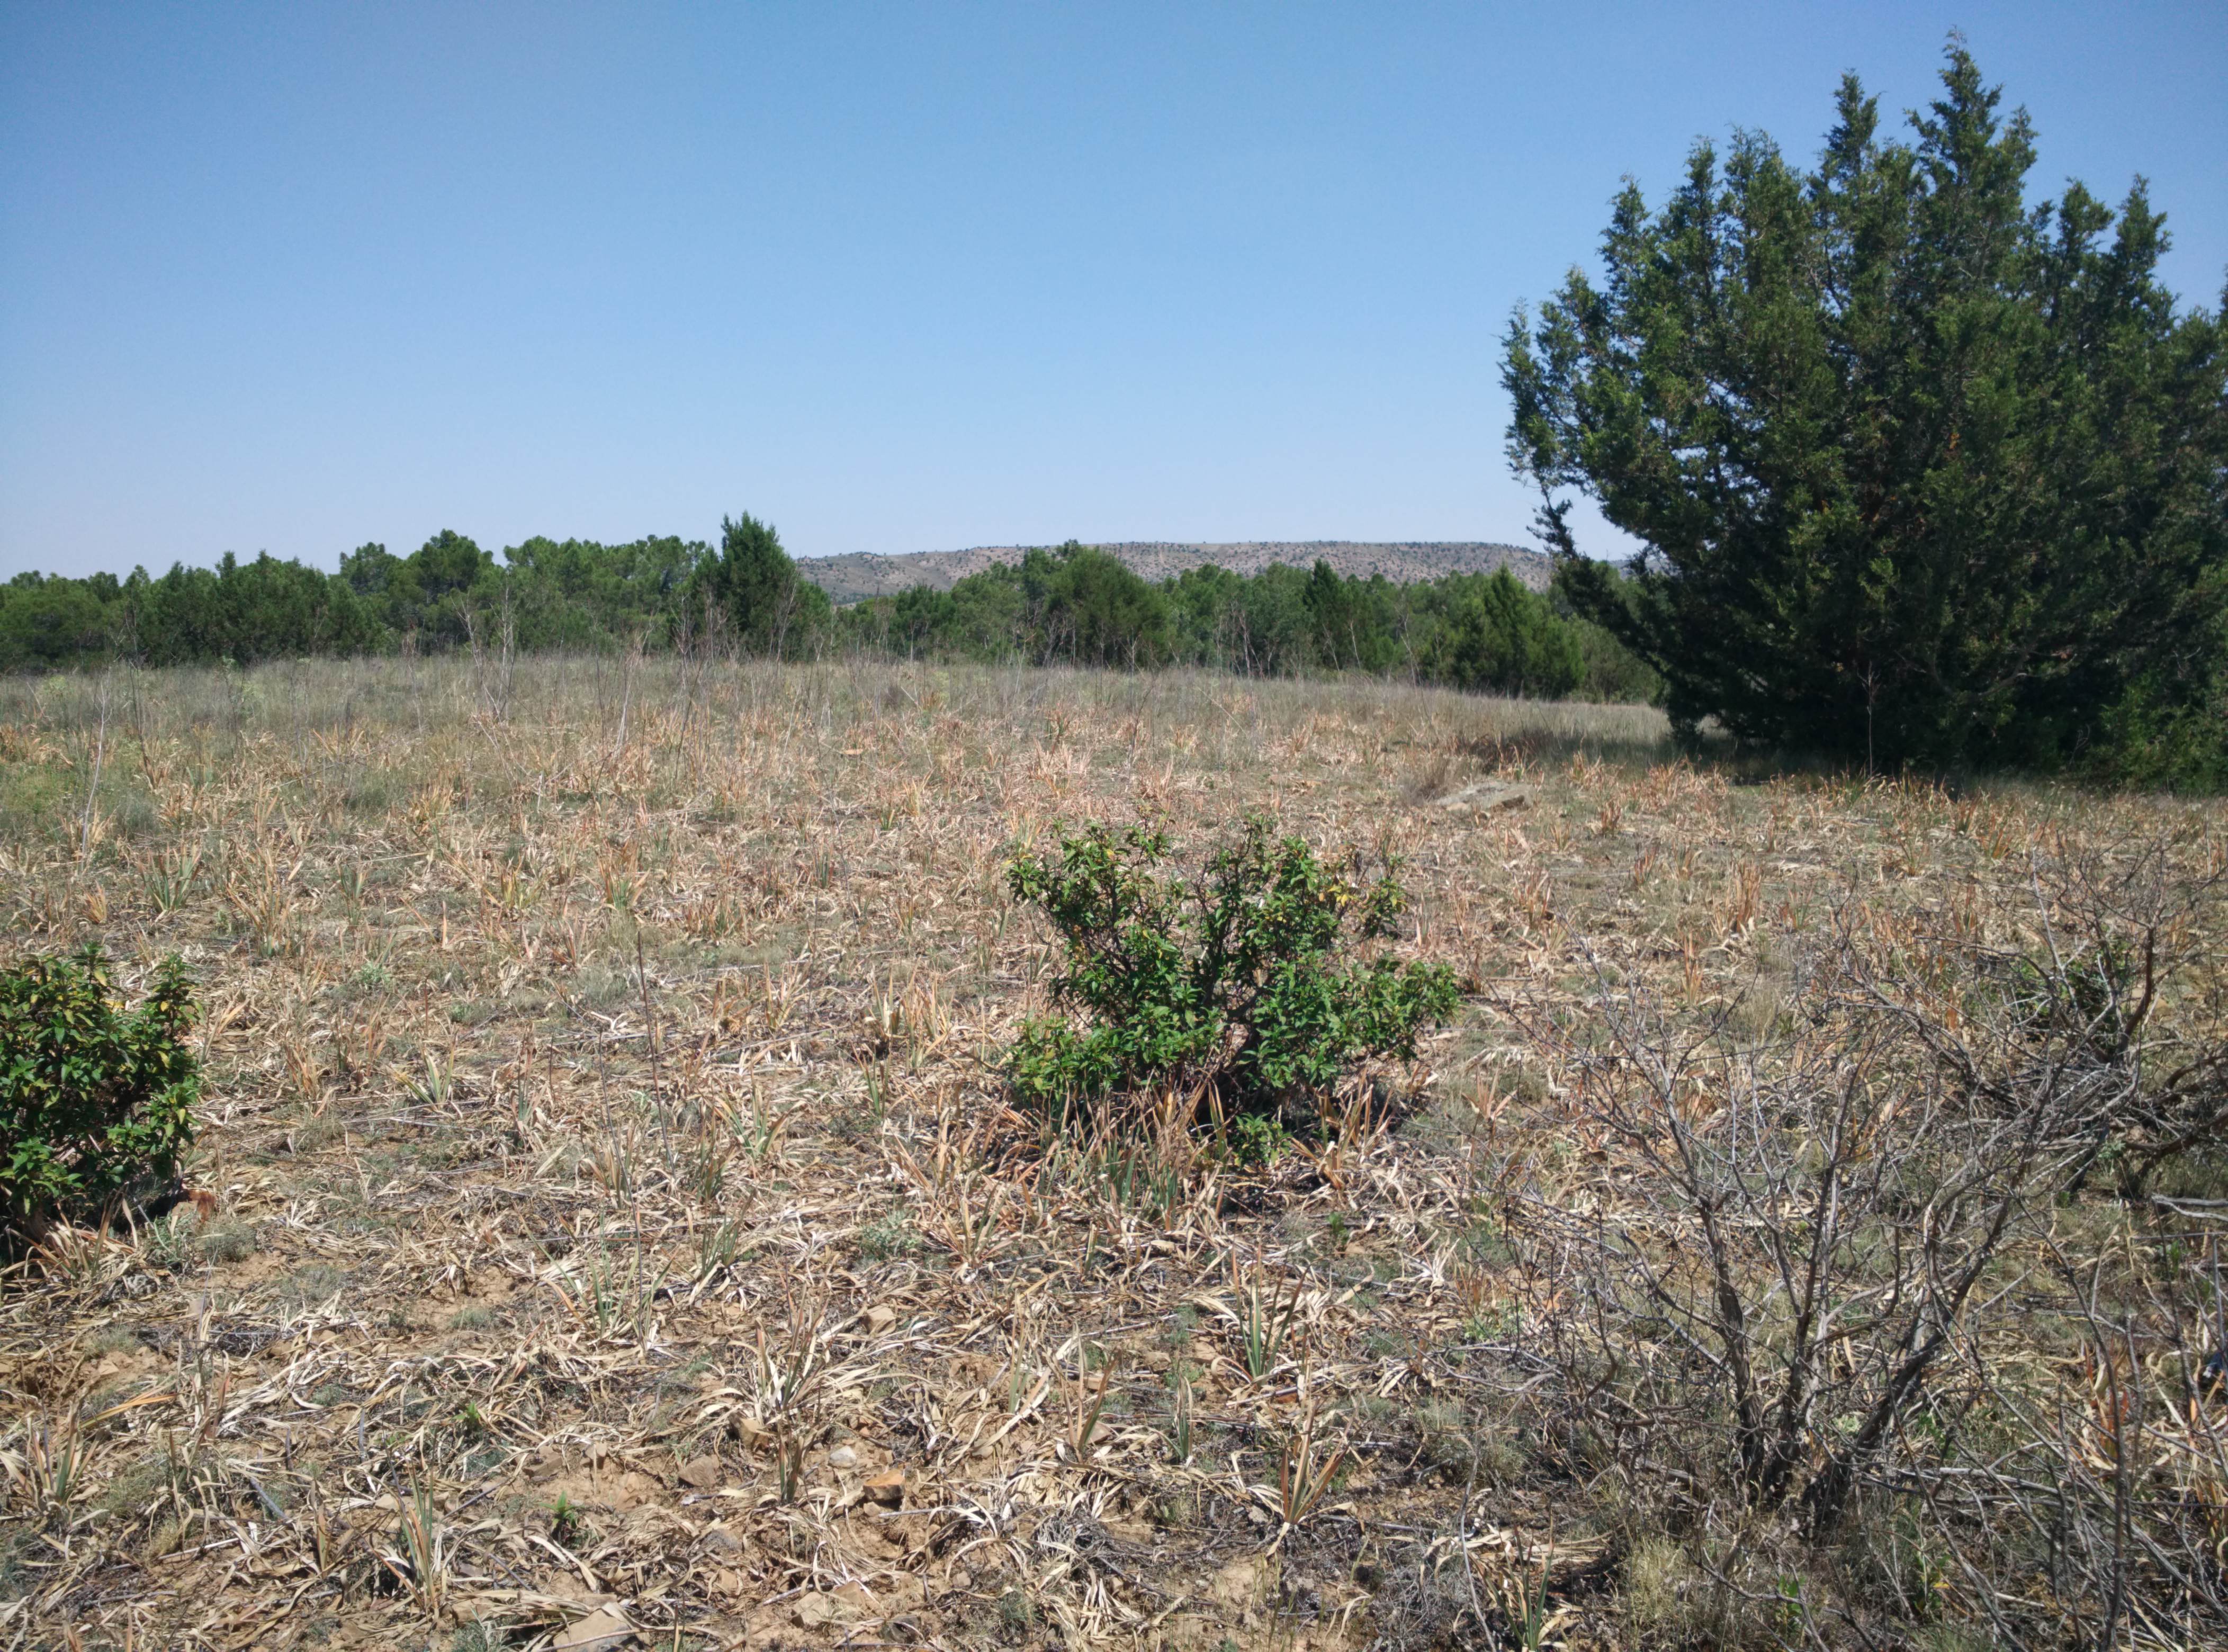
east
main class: Woodland
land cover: Pine dominated coniferous woodland
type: coniferous forest of the mediterranean region
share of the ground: 25 - 50 %
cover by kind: shrubs 60 %, coniferous forest trees 35 %, unconsolidated bare surface 5 %
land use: Semi-natural and natural areas not in use
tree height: > 5 m
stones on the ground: < 10 %
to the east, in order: Pine dominated coniferous woodland; Grassland without tree/shrub cover; Shrubland without tree cover; Pine dominated coniferous woodland; Shrubland without tree cover
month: June
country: ES
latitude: 40.8113
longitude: -1.9603
